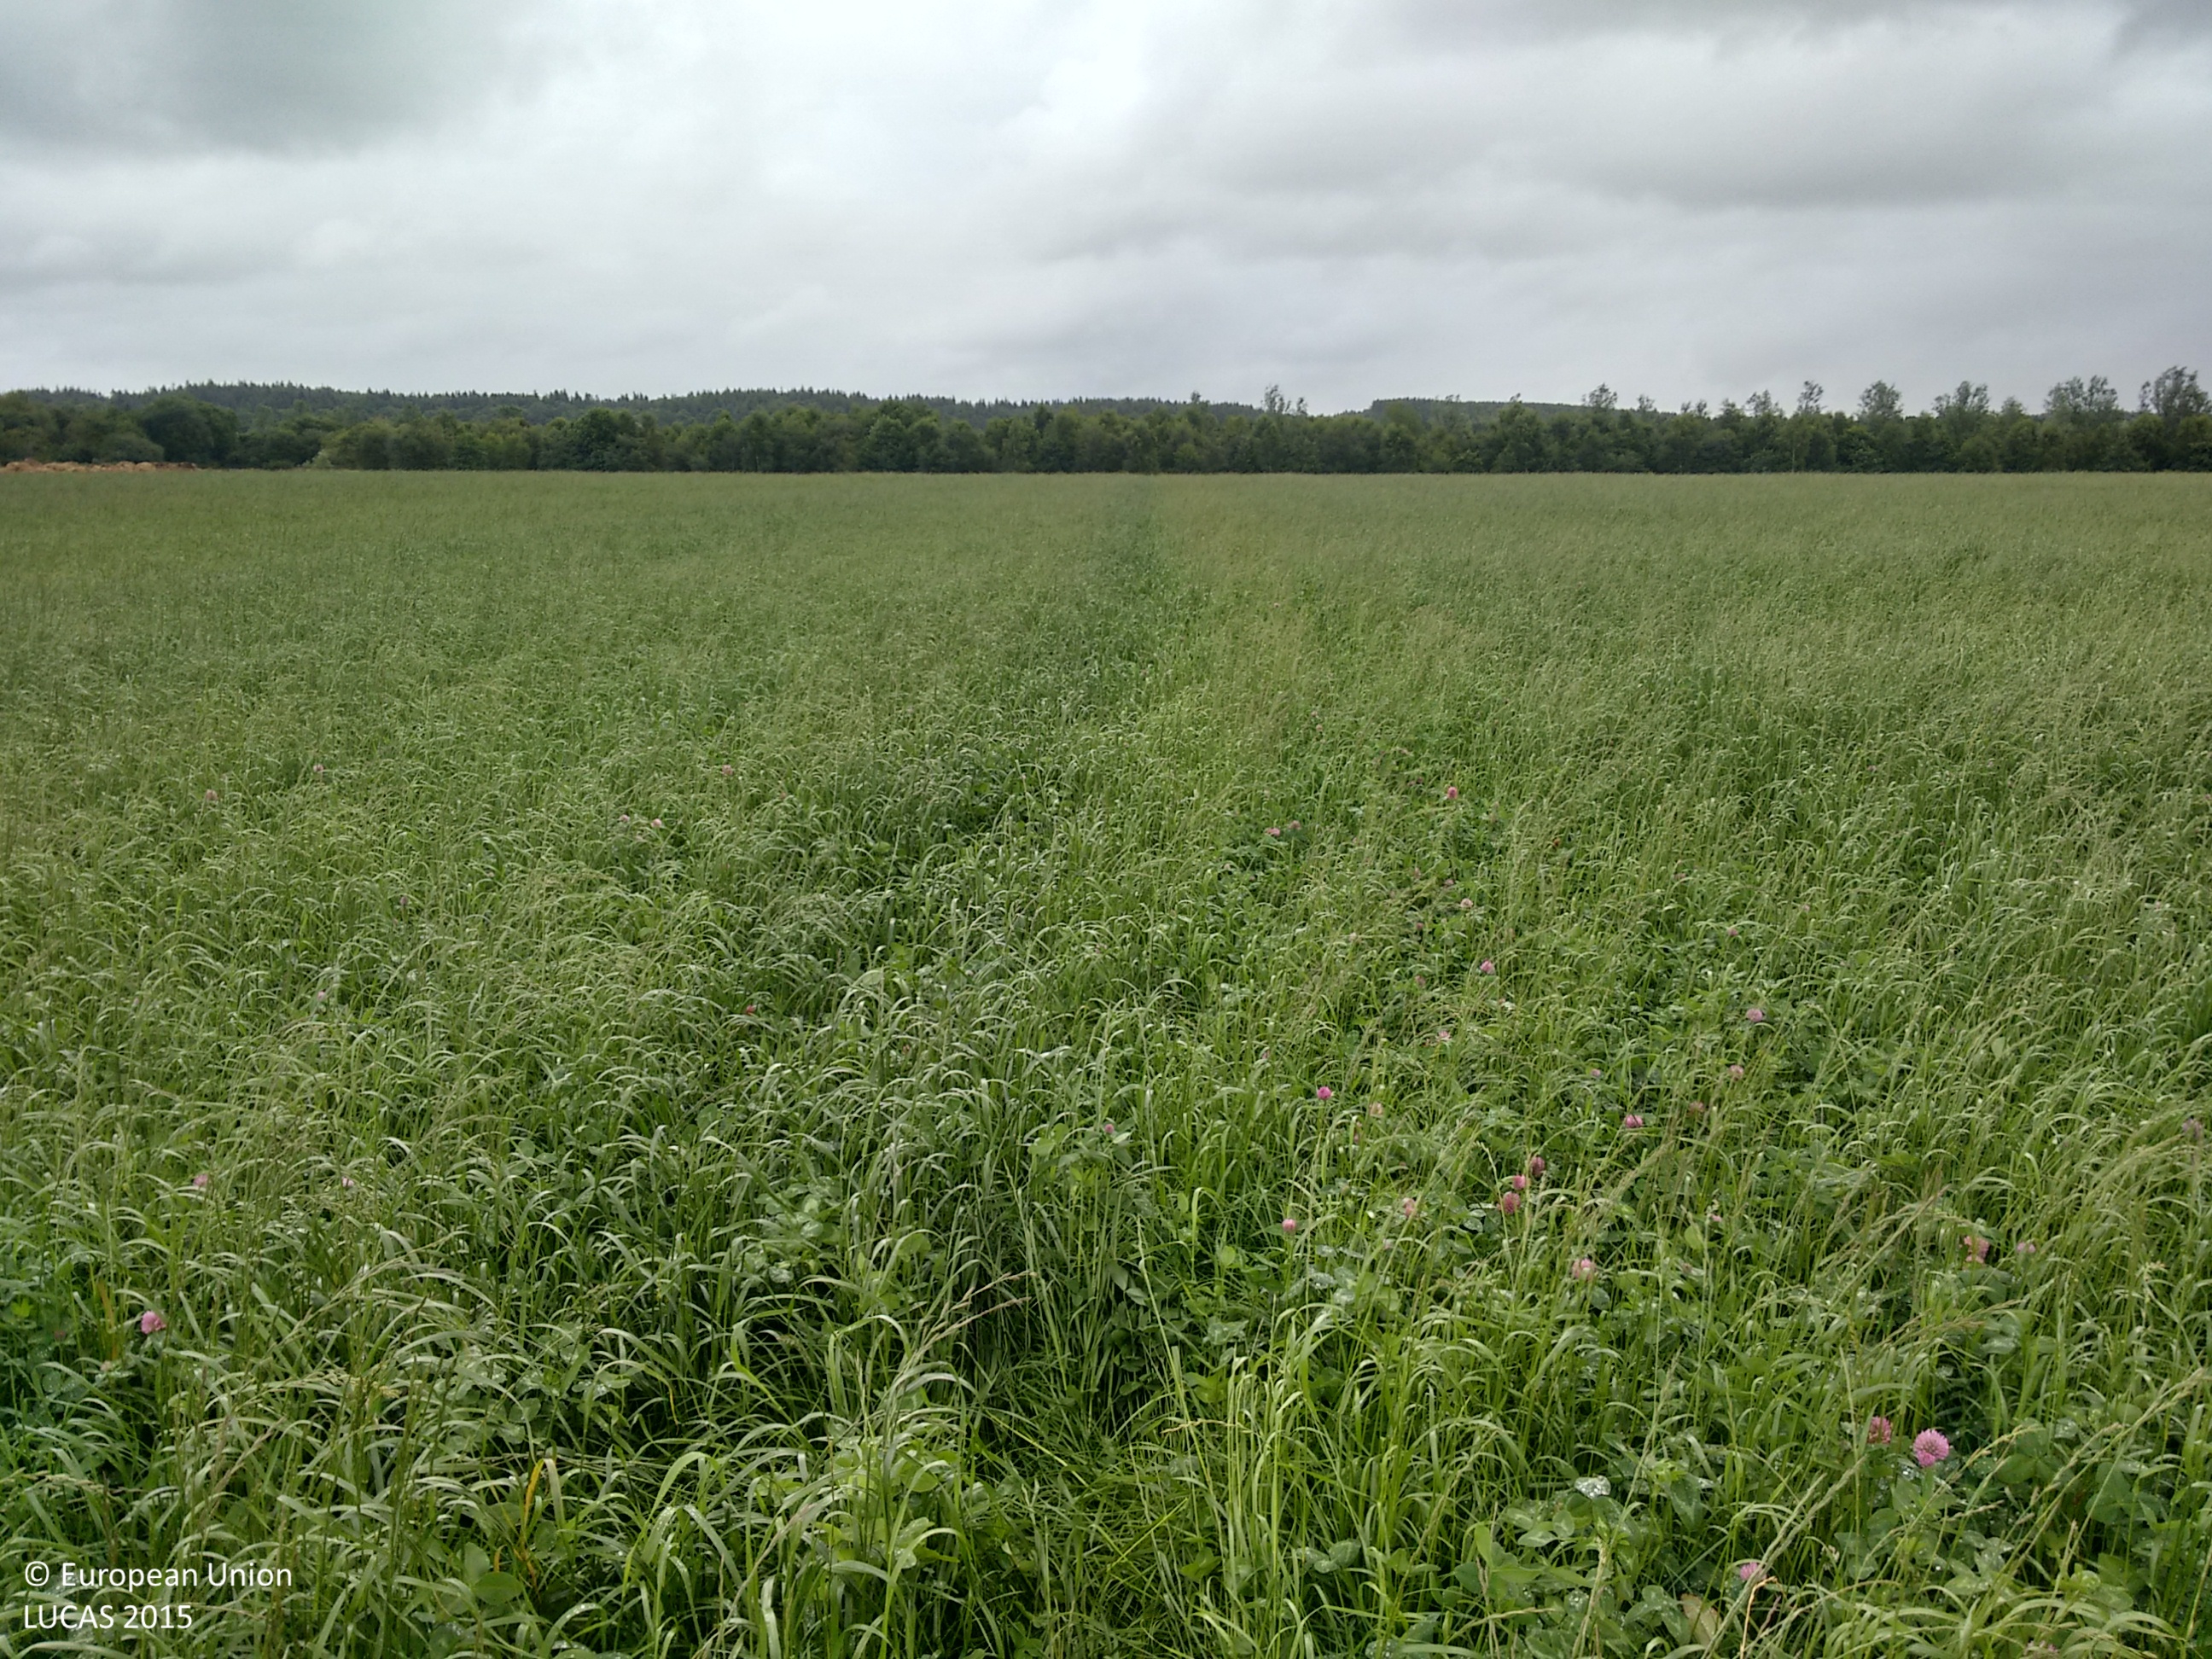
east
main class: Cropland
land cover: Temporary grasslands
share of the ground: > 75 %
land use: Agriculture (excluding fallow land and kitchen gardens)
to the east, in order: Temporary grasslands; Fences; Broadleaved woodland; Inland fresh water bodies; Grass margins; Fences; Grass margins; Tracks
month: September
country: GB
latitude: 57.6231
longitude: -3.3445
